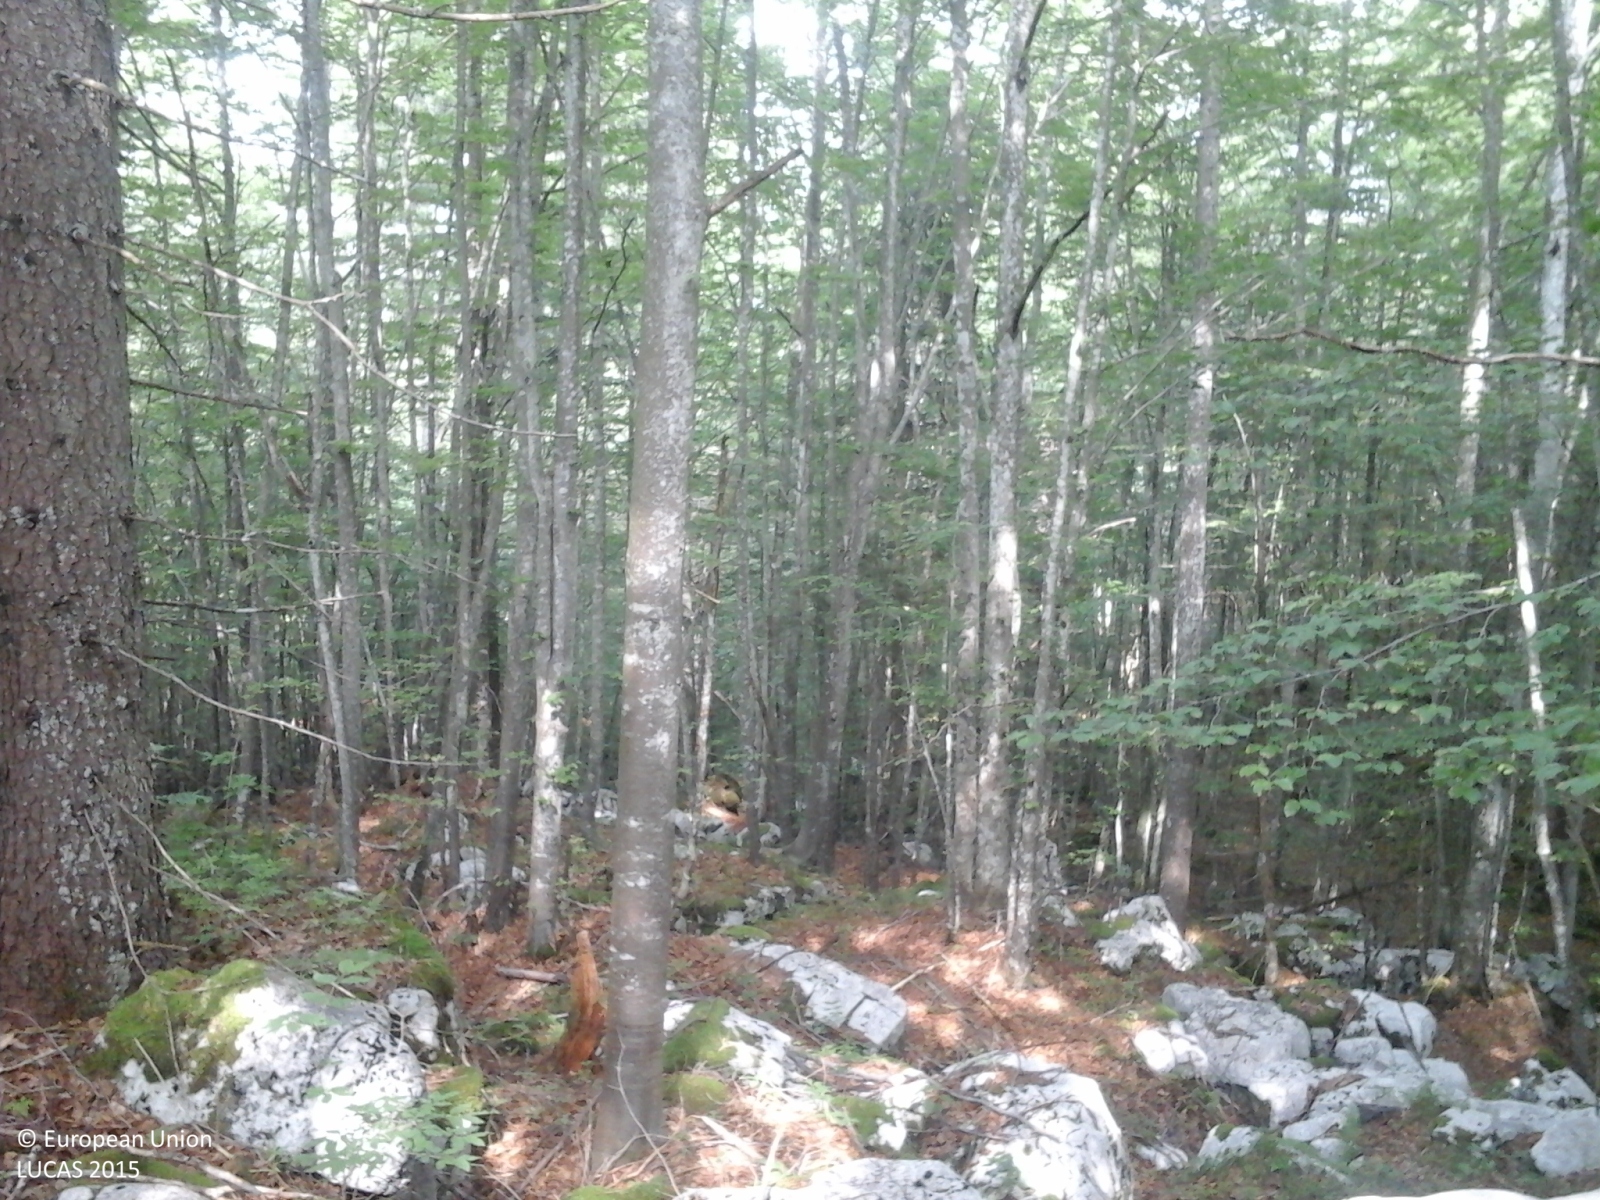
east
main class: Woodland
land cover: Broadleaved woodland
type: mountainous beech forest
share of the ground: > 75 %
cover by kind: broadleaved forest trees 100 %
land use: Forestry
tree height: > 5 m
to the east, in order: Broadleaved woodland
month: June
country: IT
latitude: 45.8530
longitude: 11.5817
